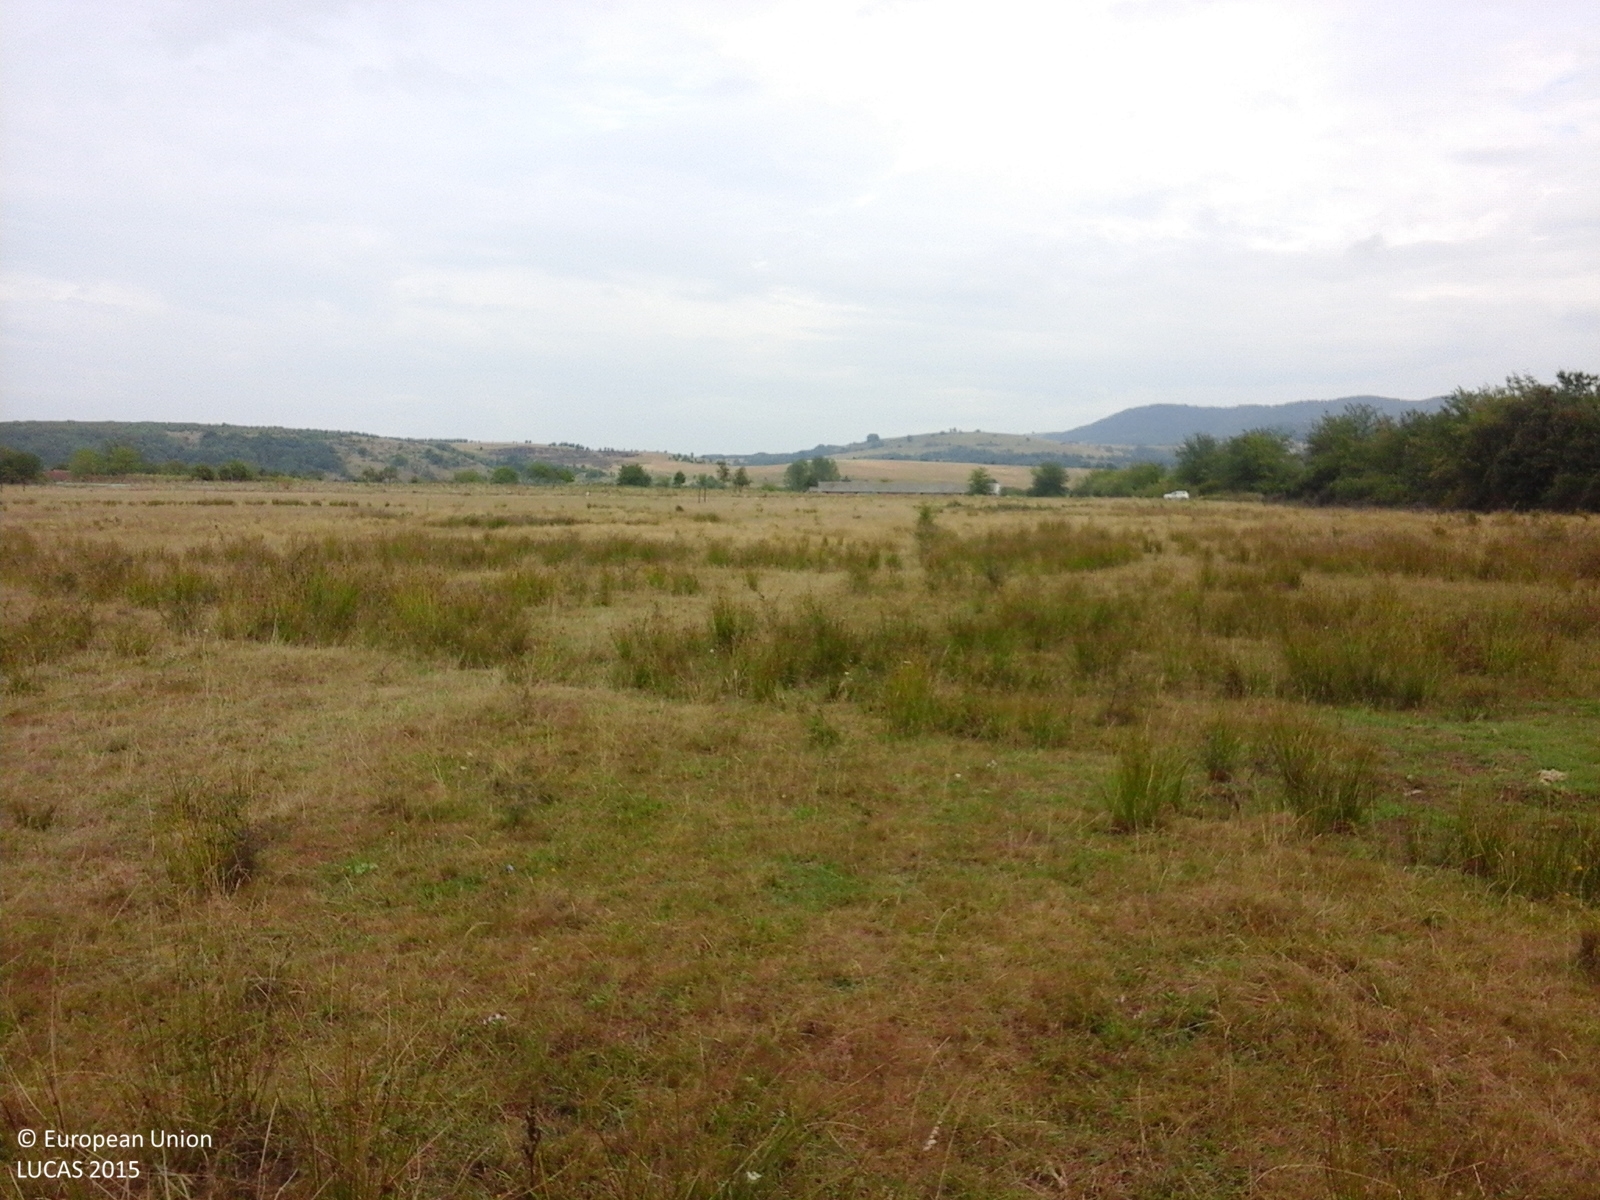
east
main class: Grassland
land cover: Grassland without tree/shrub cover
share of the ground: > 75 %
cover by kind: herbaceous plants 100 %
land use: Agriculture (excluding fallow land and kitchen gardens)
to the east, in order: Grassland without tree/shrub cover
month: August
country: RO
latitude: 45.4865
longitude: 21.7163
